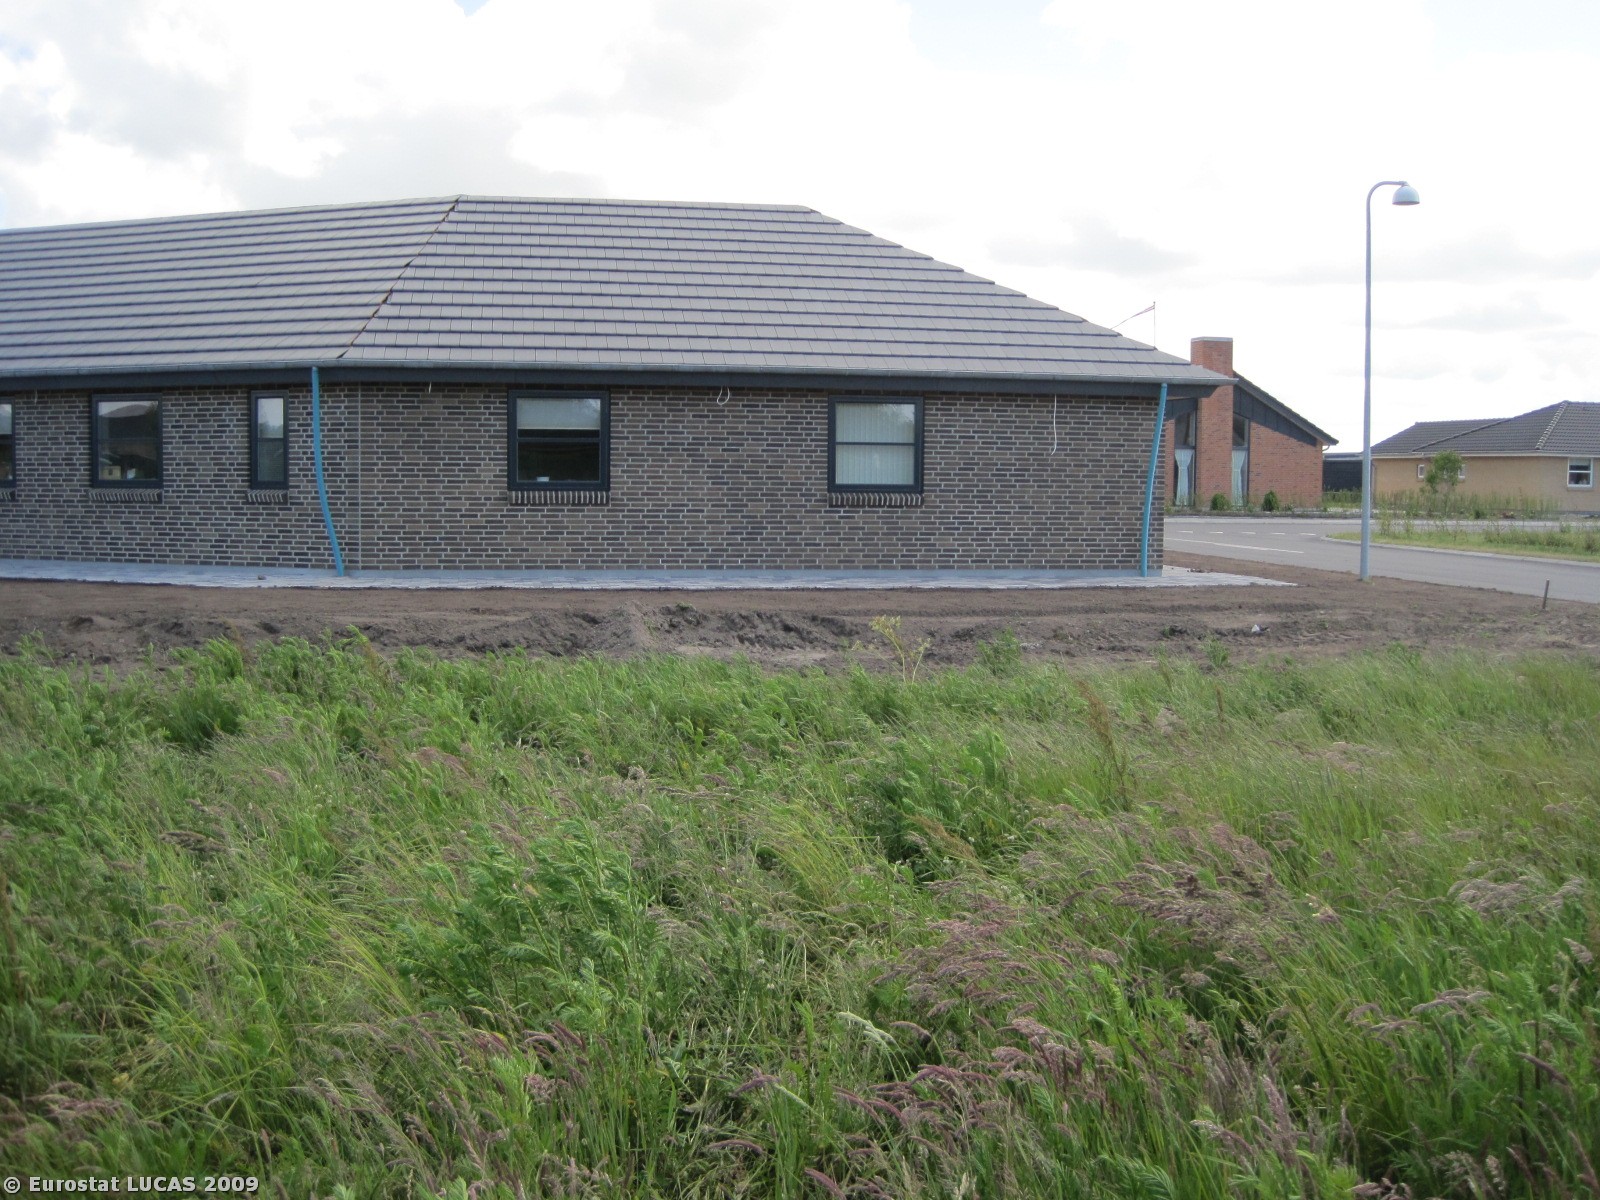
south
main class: Grassland
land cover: Grassland without tree/shrub cover
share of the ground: > 75 %
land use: Unused
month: June
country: DK
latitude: 57.1583
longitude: 9.7524
